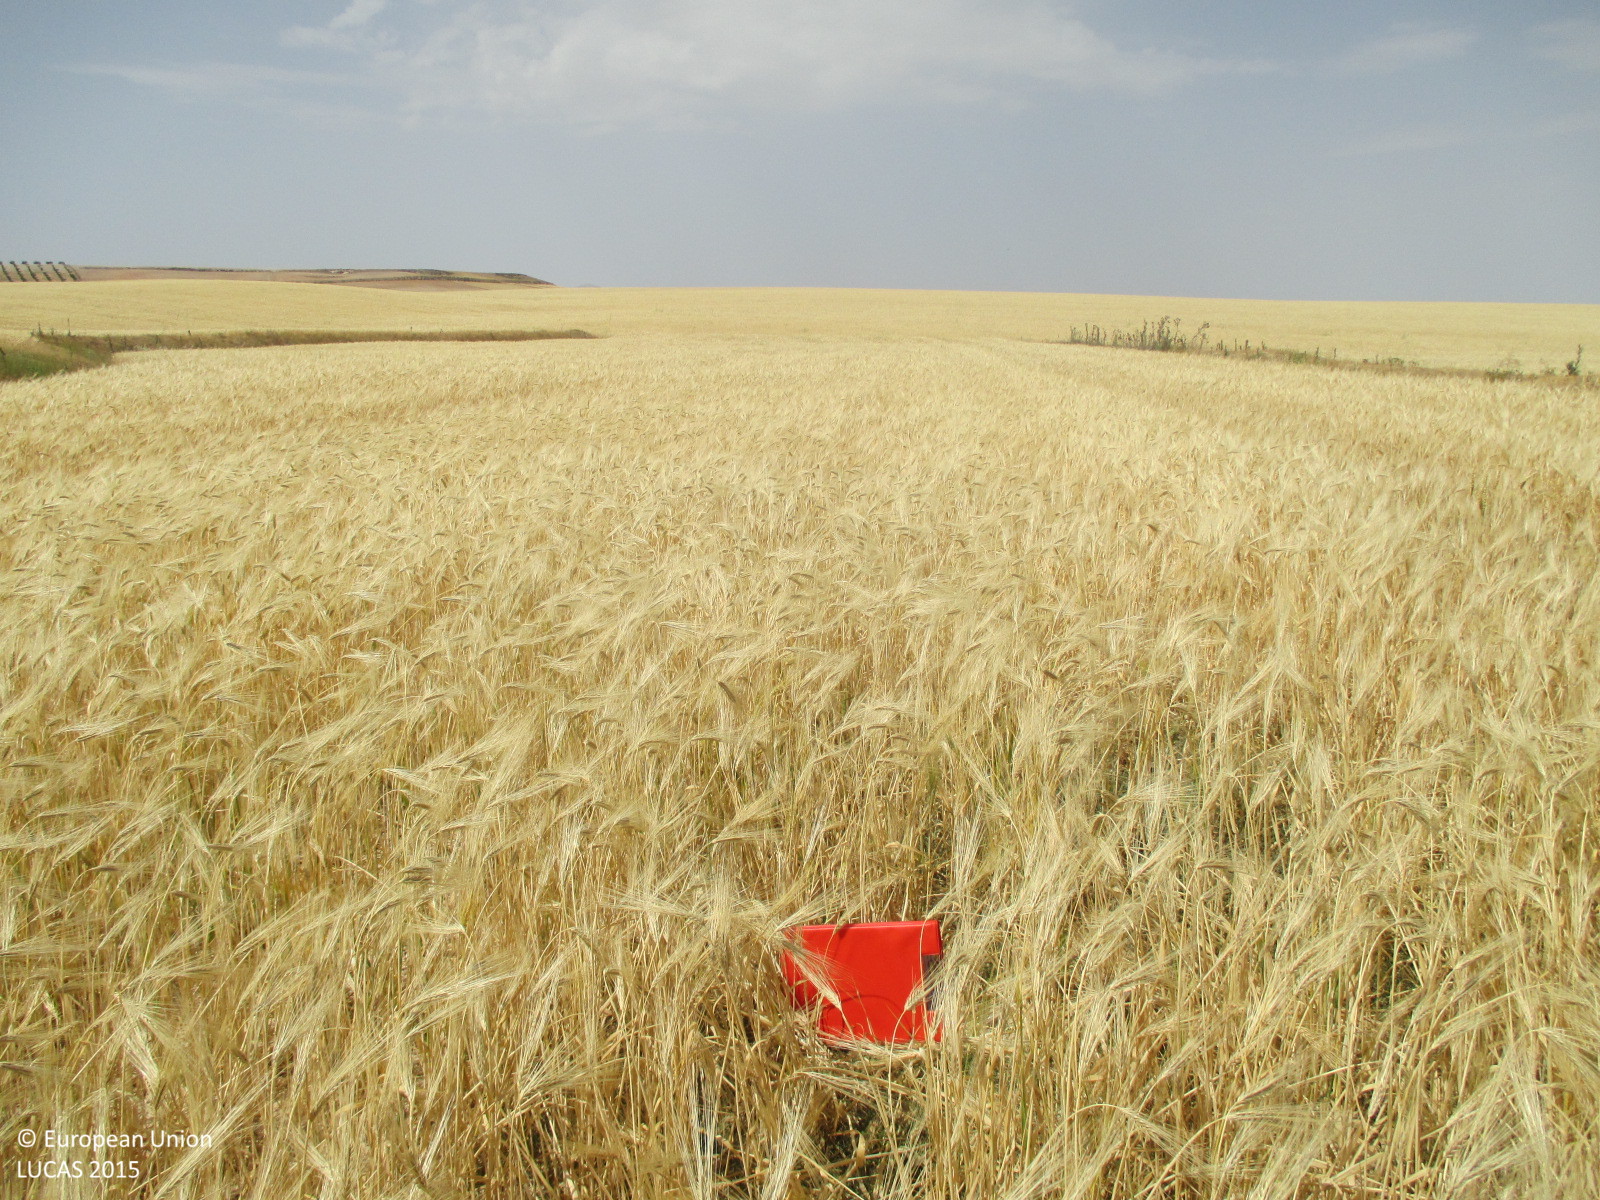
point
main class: Cropland
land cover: Barley
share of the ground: > 75 %
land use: Agriculture (excluding fallow land and kitchen gardens)
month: July
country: ES
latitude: 37.7932
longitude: -2.2637
